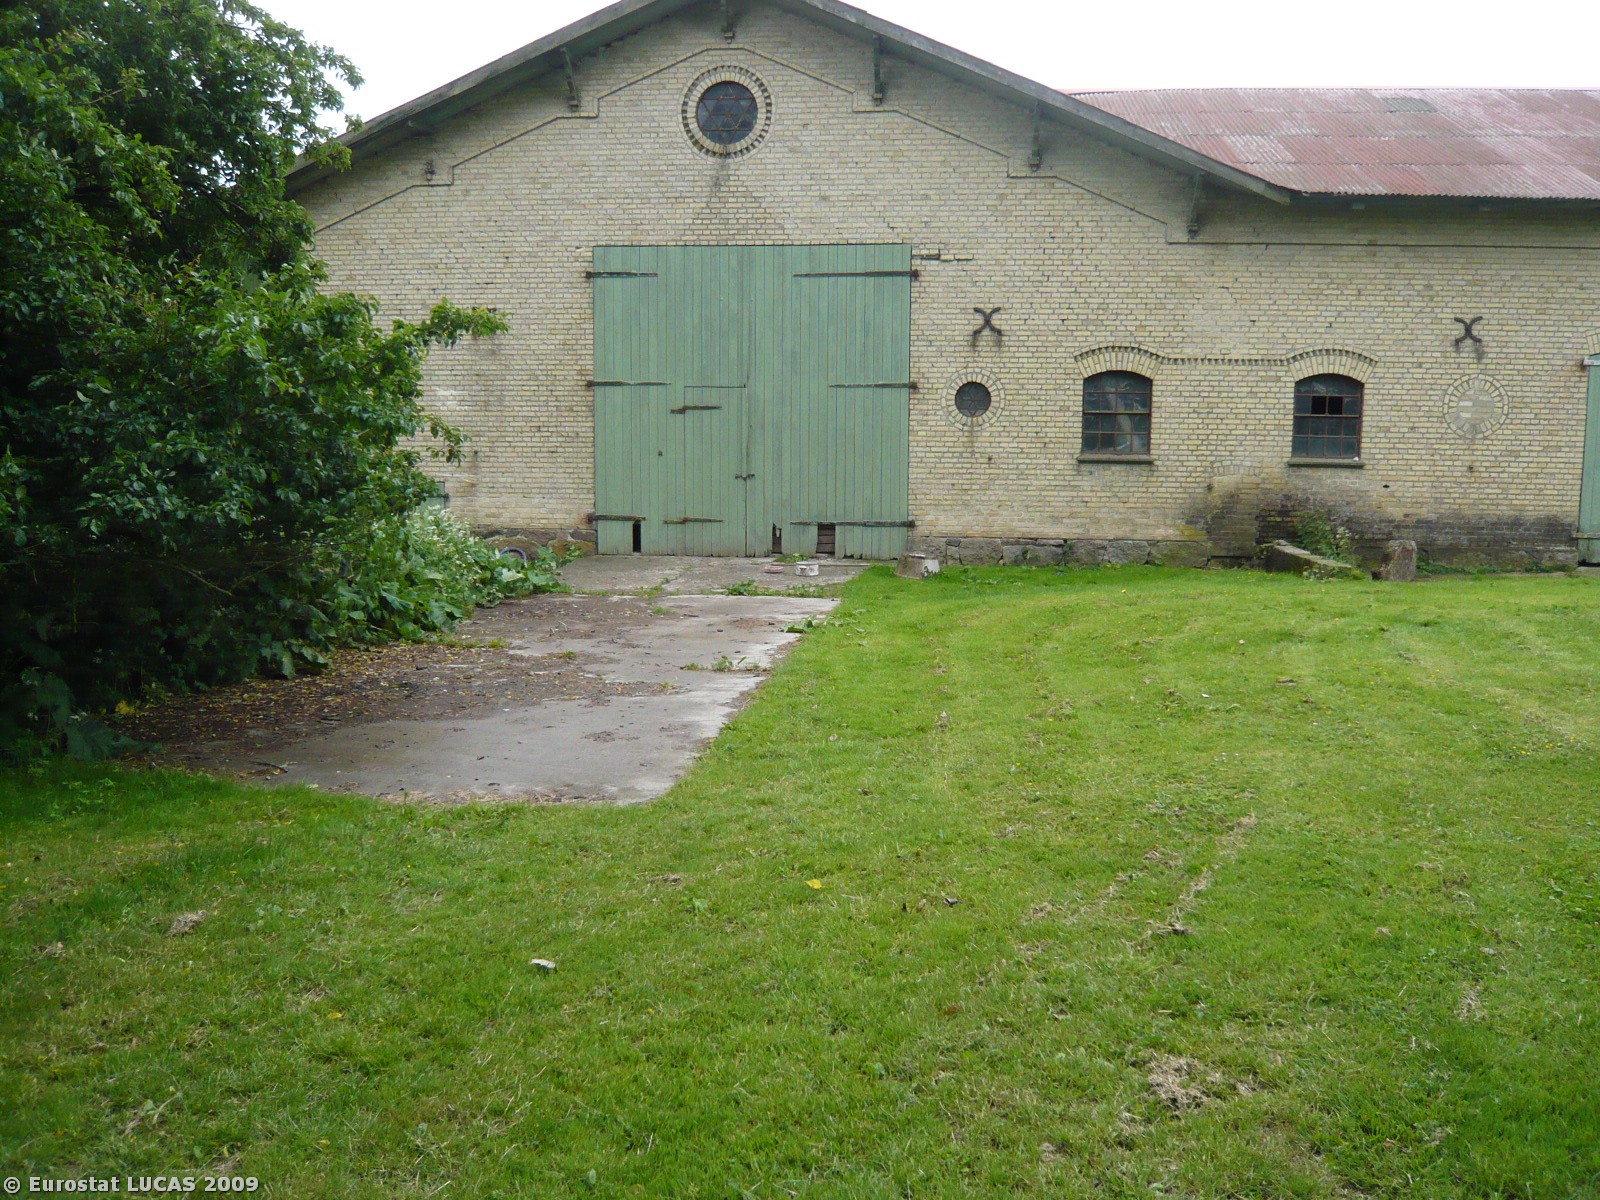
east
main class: Grassland
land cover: Grassland without tree/shrub cover
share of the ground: > 75 %
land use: Agriculture (excluding fallow land and kitchen gardens)
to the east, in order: Grassland without tree/shrub cover; Artificial constructions in urban areas; Tracks; Broadleaved woodland; Temporary grasslands
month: June
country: DK
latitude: 54.9323
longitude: 11.9496
